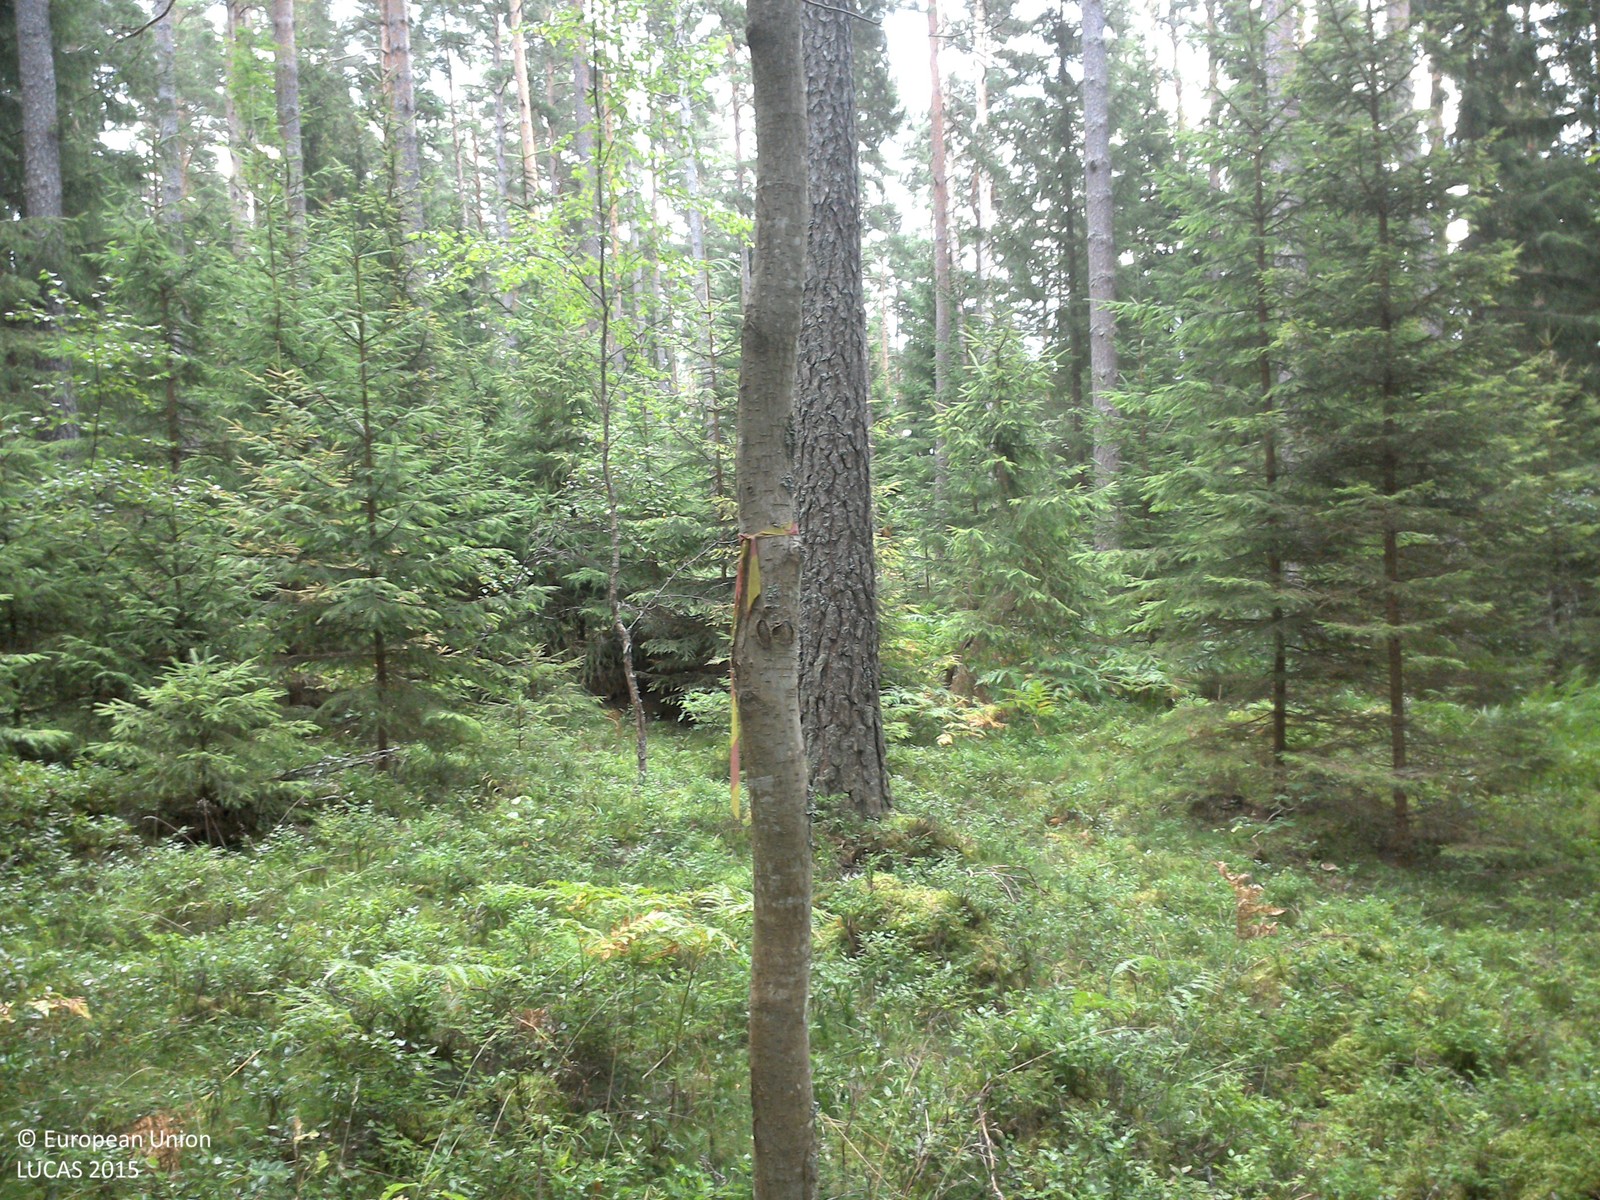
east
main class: Woodland
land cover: Pine dominated coniferous woodland
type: boreal forest
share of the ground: 25 - 50 %
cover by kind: coniferous forest trees 45 %, lichens and mosses 45 %, herbaceous plants 10 %
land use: Forestry
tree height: > 5 m
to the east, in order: Pine dominated coniferous woodland; Tracks; Pine dominated coniferous woodland; Spruce dominated coniferous woodland
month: August
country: SE
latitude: 57.8113
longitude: 15.2300
